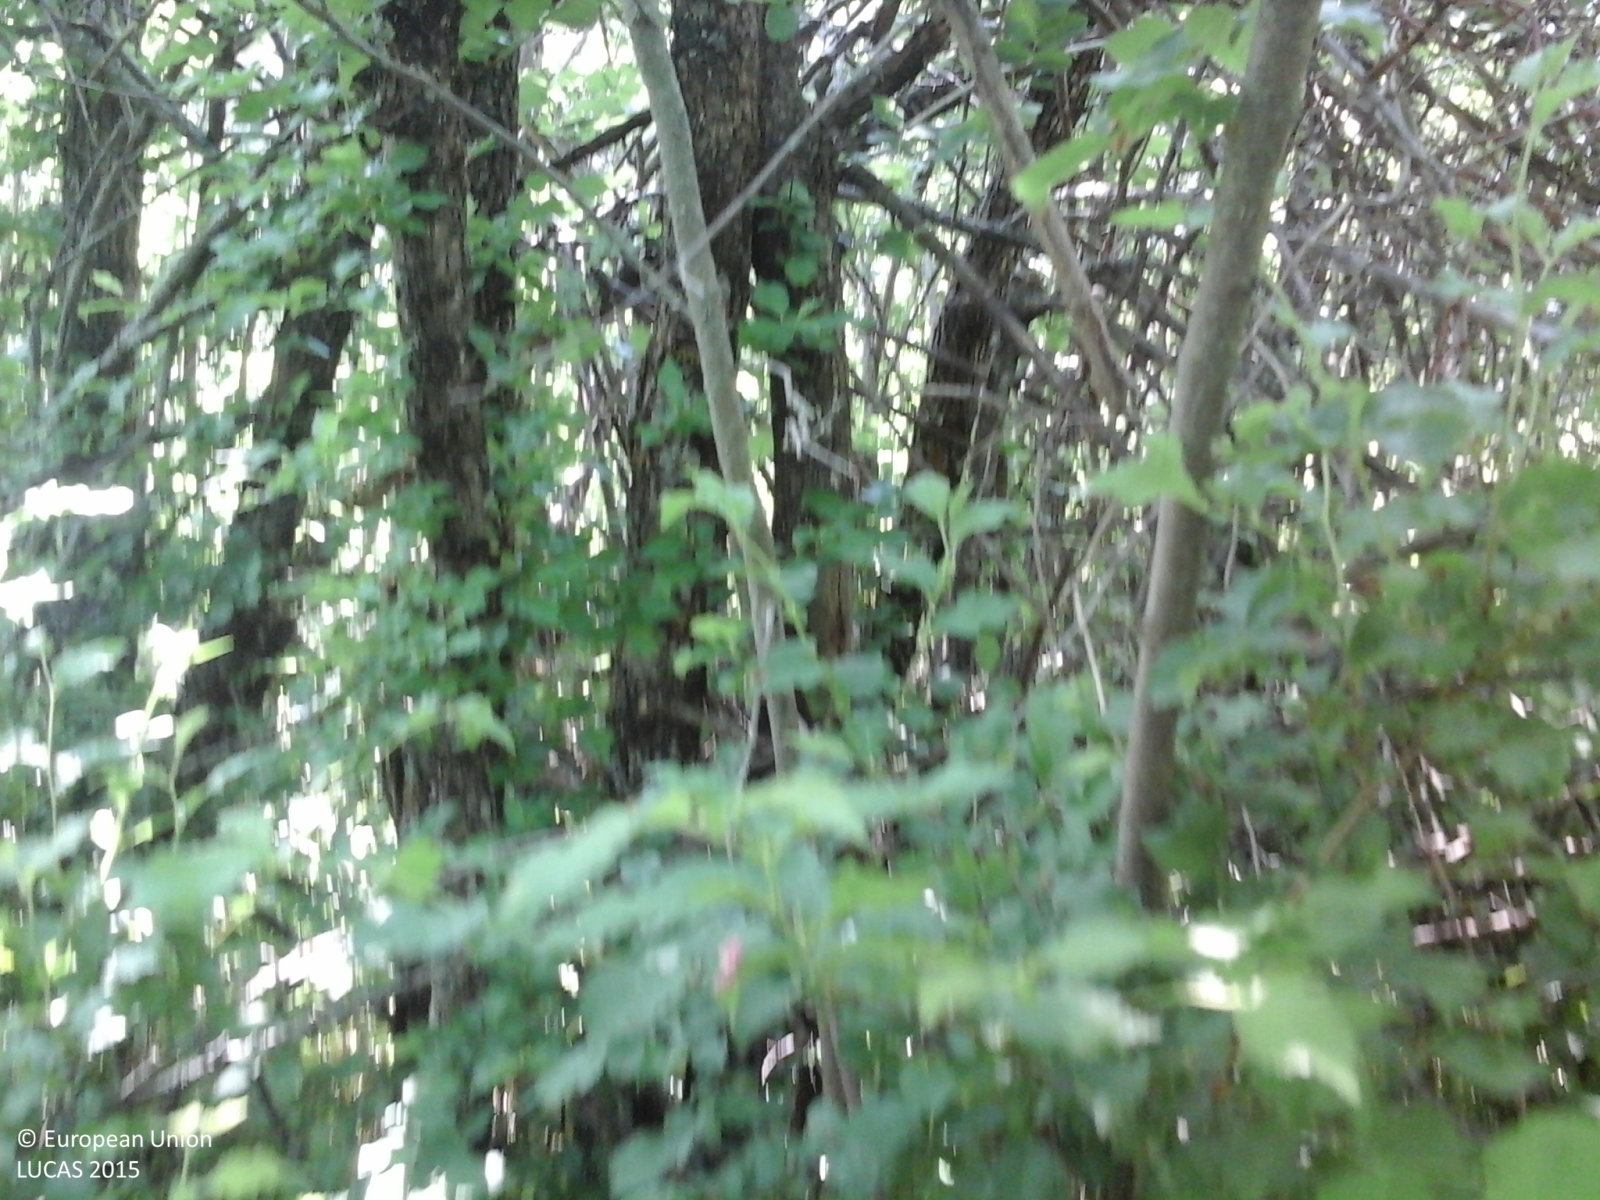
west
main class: Woodland
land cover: Broadleaved woodland
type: thermophilous deciduous forest
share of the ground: > 75 %
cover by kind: broadleaved forest trees 100 %
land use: Forestry
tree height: > 5 m
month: May
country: IT
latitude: 44.2003
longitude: 11.1110
